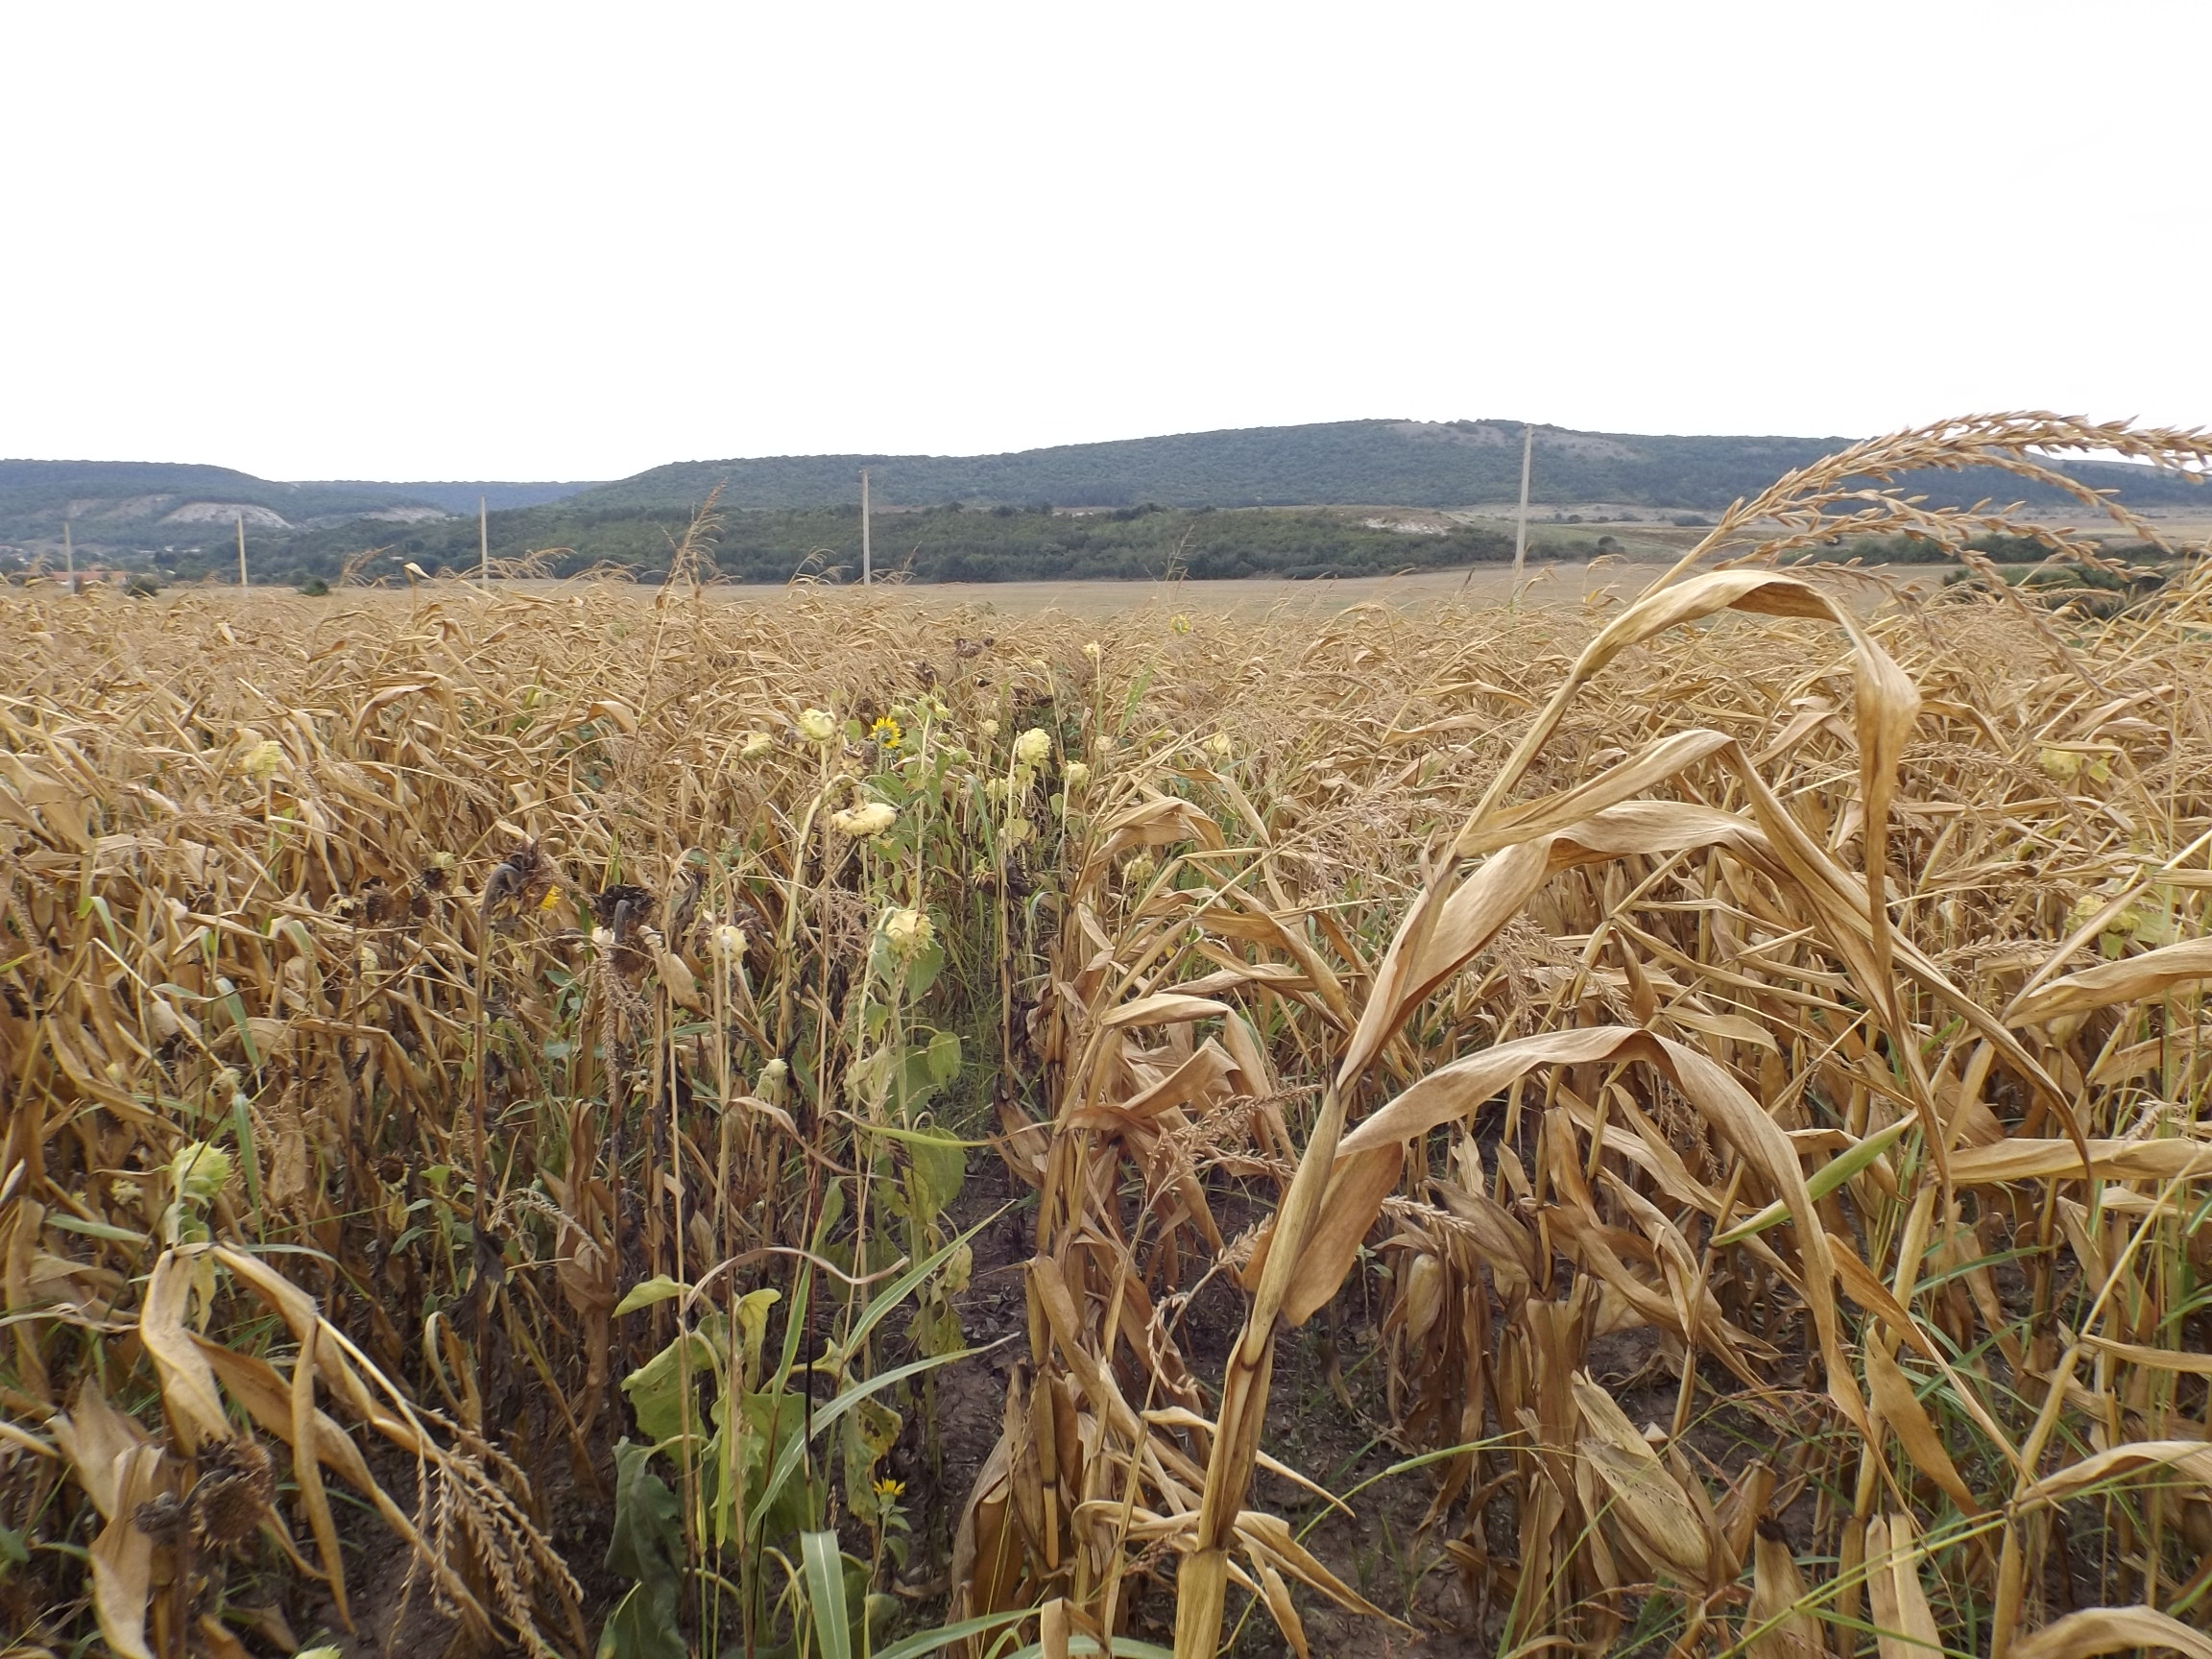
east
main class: Cropland
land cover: Maize
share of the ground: > 75 %
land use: Agriculture (excluding fallow land and kitchen gardens)
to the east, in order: Maize; Tracks; Grass margins; Common wheat
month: August
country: BG
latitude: 43.2539
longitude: 27.6096
